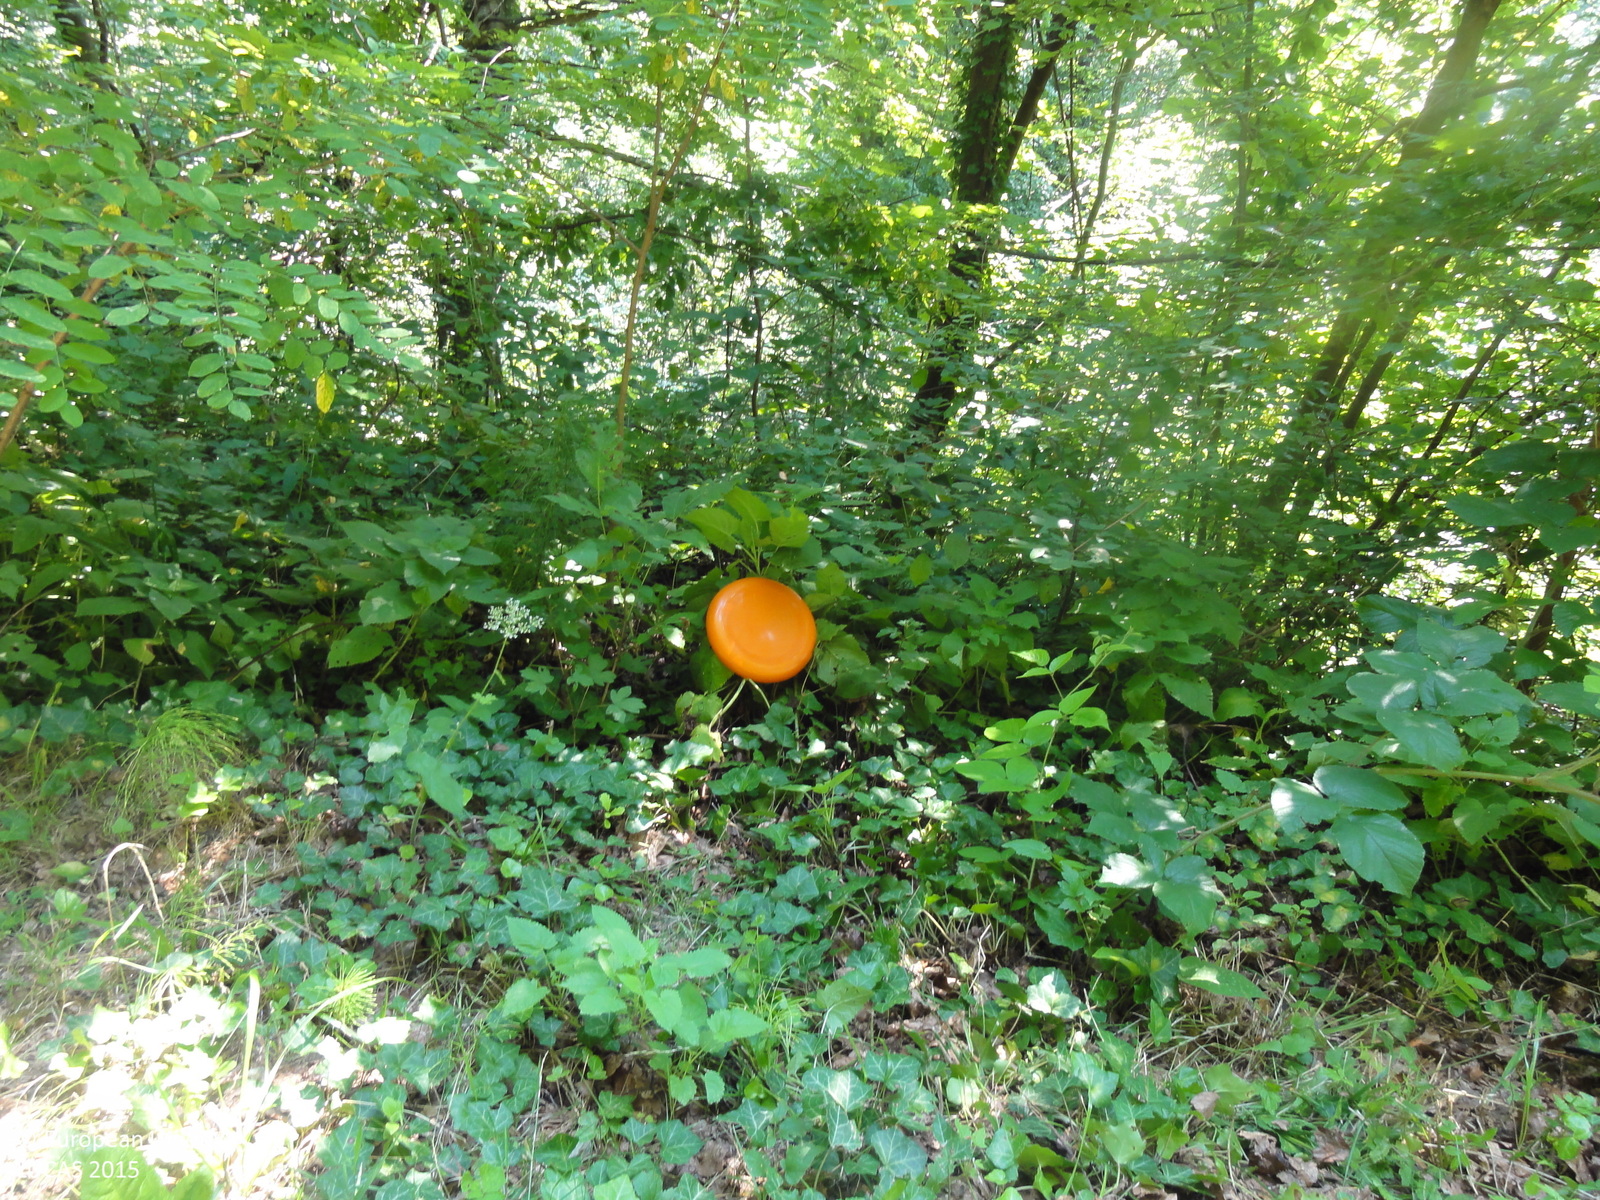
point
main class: Woodland
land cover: Broadleaved woodland
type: beech forest
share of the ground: > 75 %
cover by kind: broadleaved forest trees 85 %, shrubs 10 %, unconsolidated bare surface 5 %
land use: Forestry
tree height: > 5 m
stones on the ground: < 10 %
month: August
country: SI
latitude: 46.1735
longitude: 15.5029
